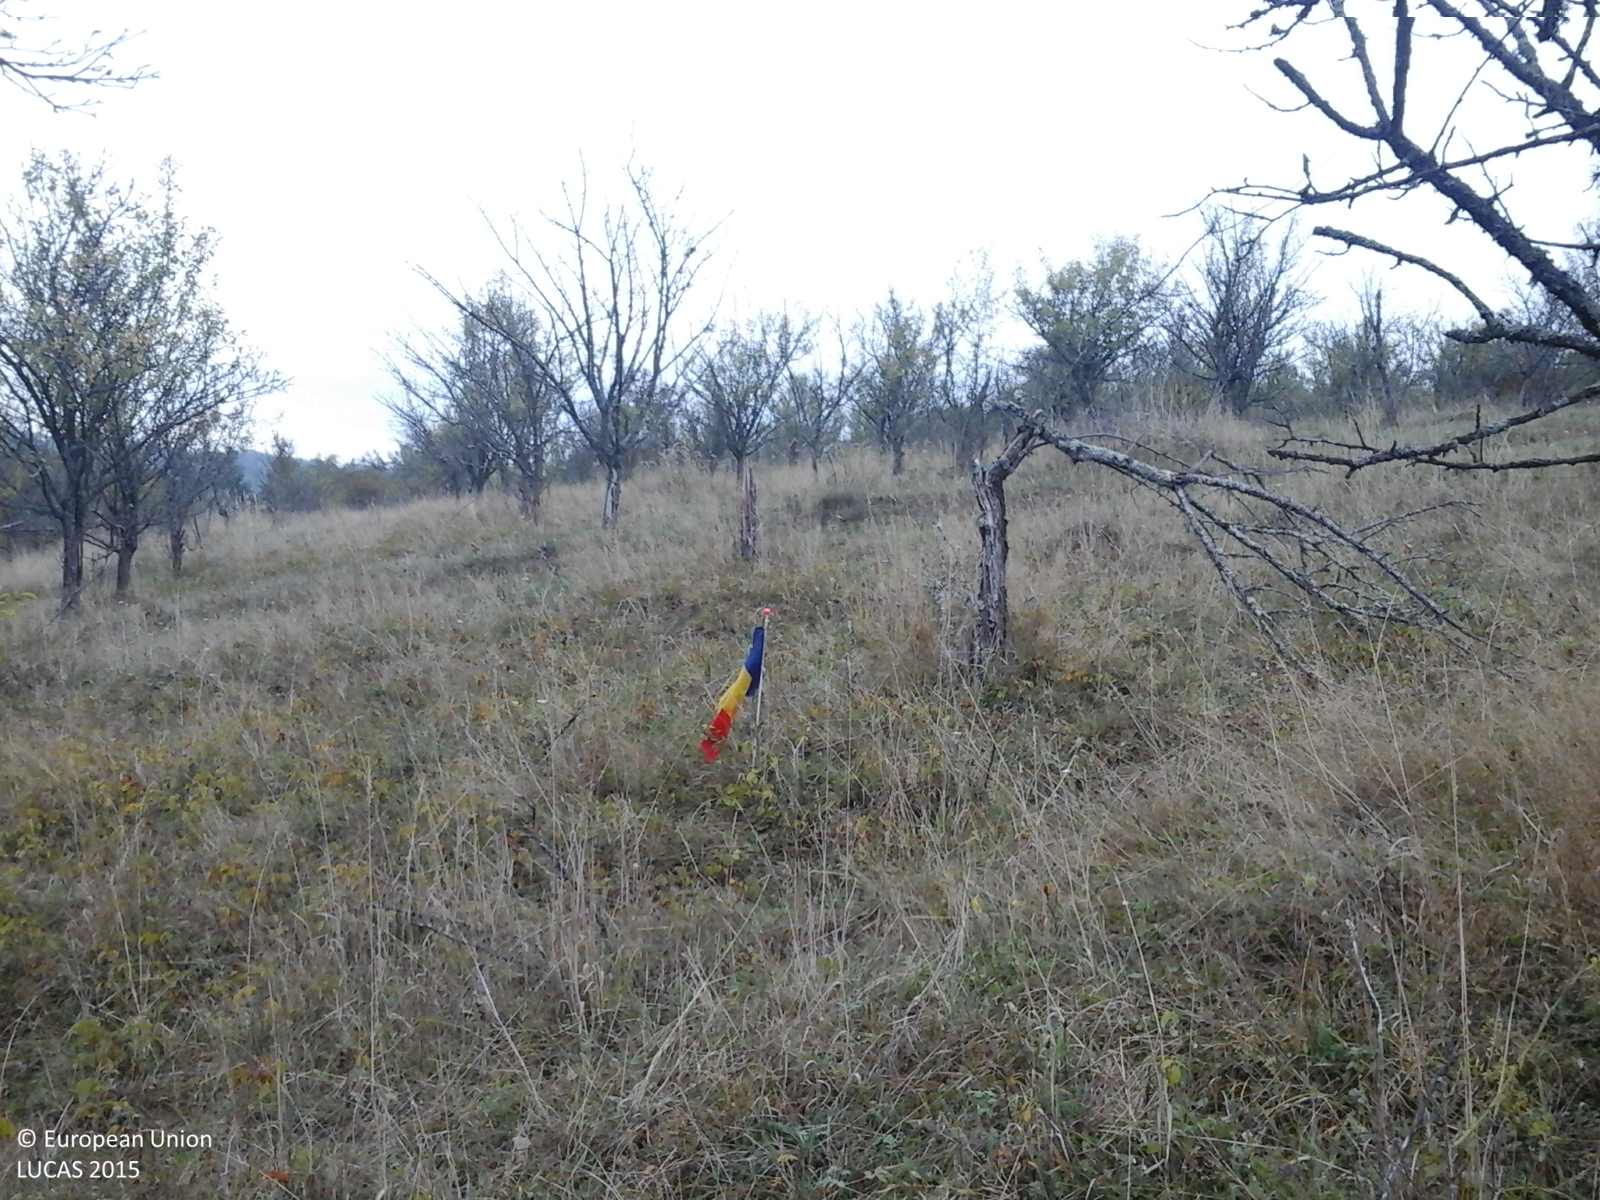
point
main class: Cropland
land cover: Apple fruit
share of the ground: > 75 %
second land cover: Grassland without tree/shrub cover
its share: > 75 %
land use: Agriculture (excluding fallow land and kitchen gardens)
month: September
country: RO
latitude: 45.5261
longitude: 22.0101
